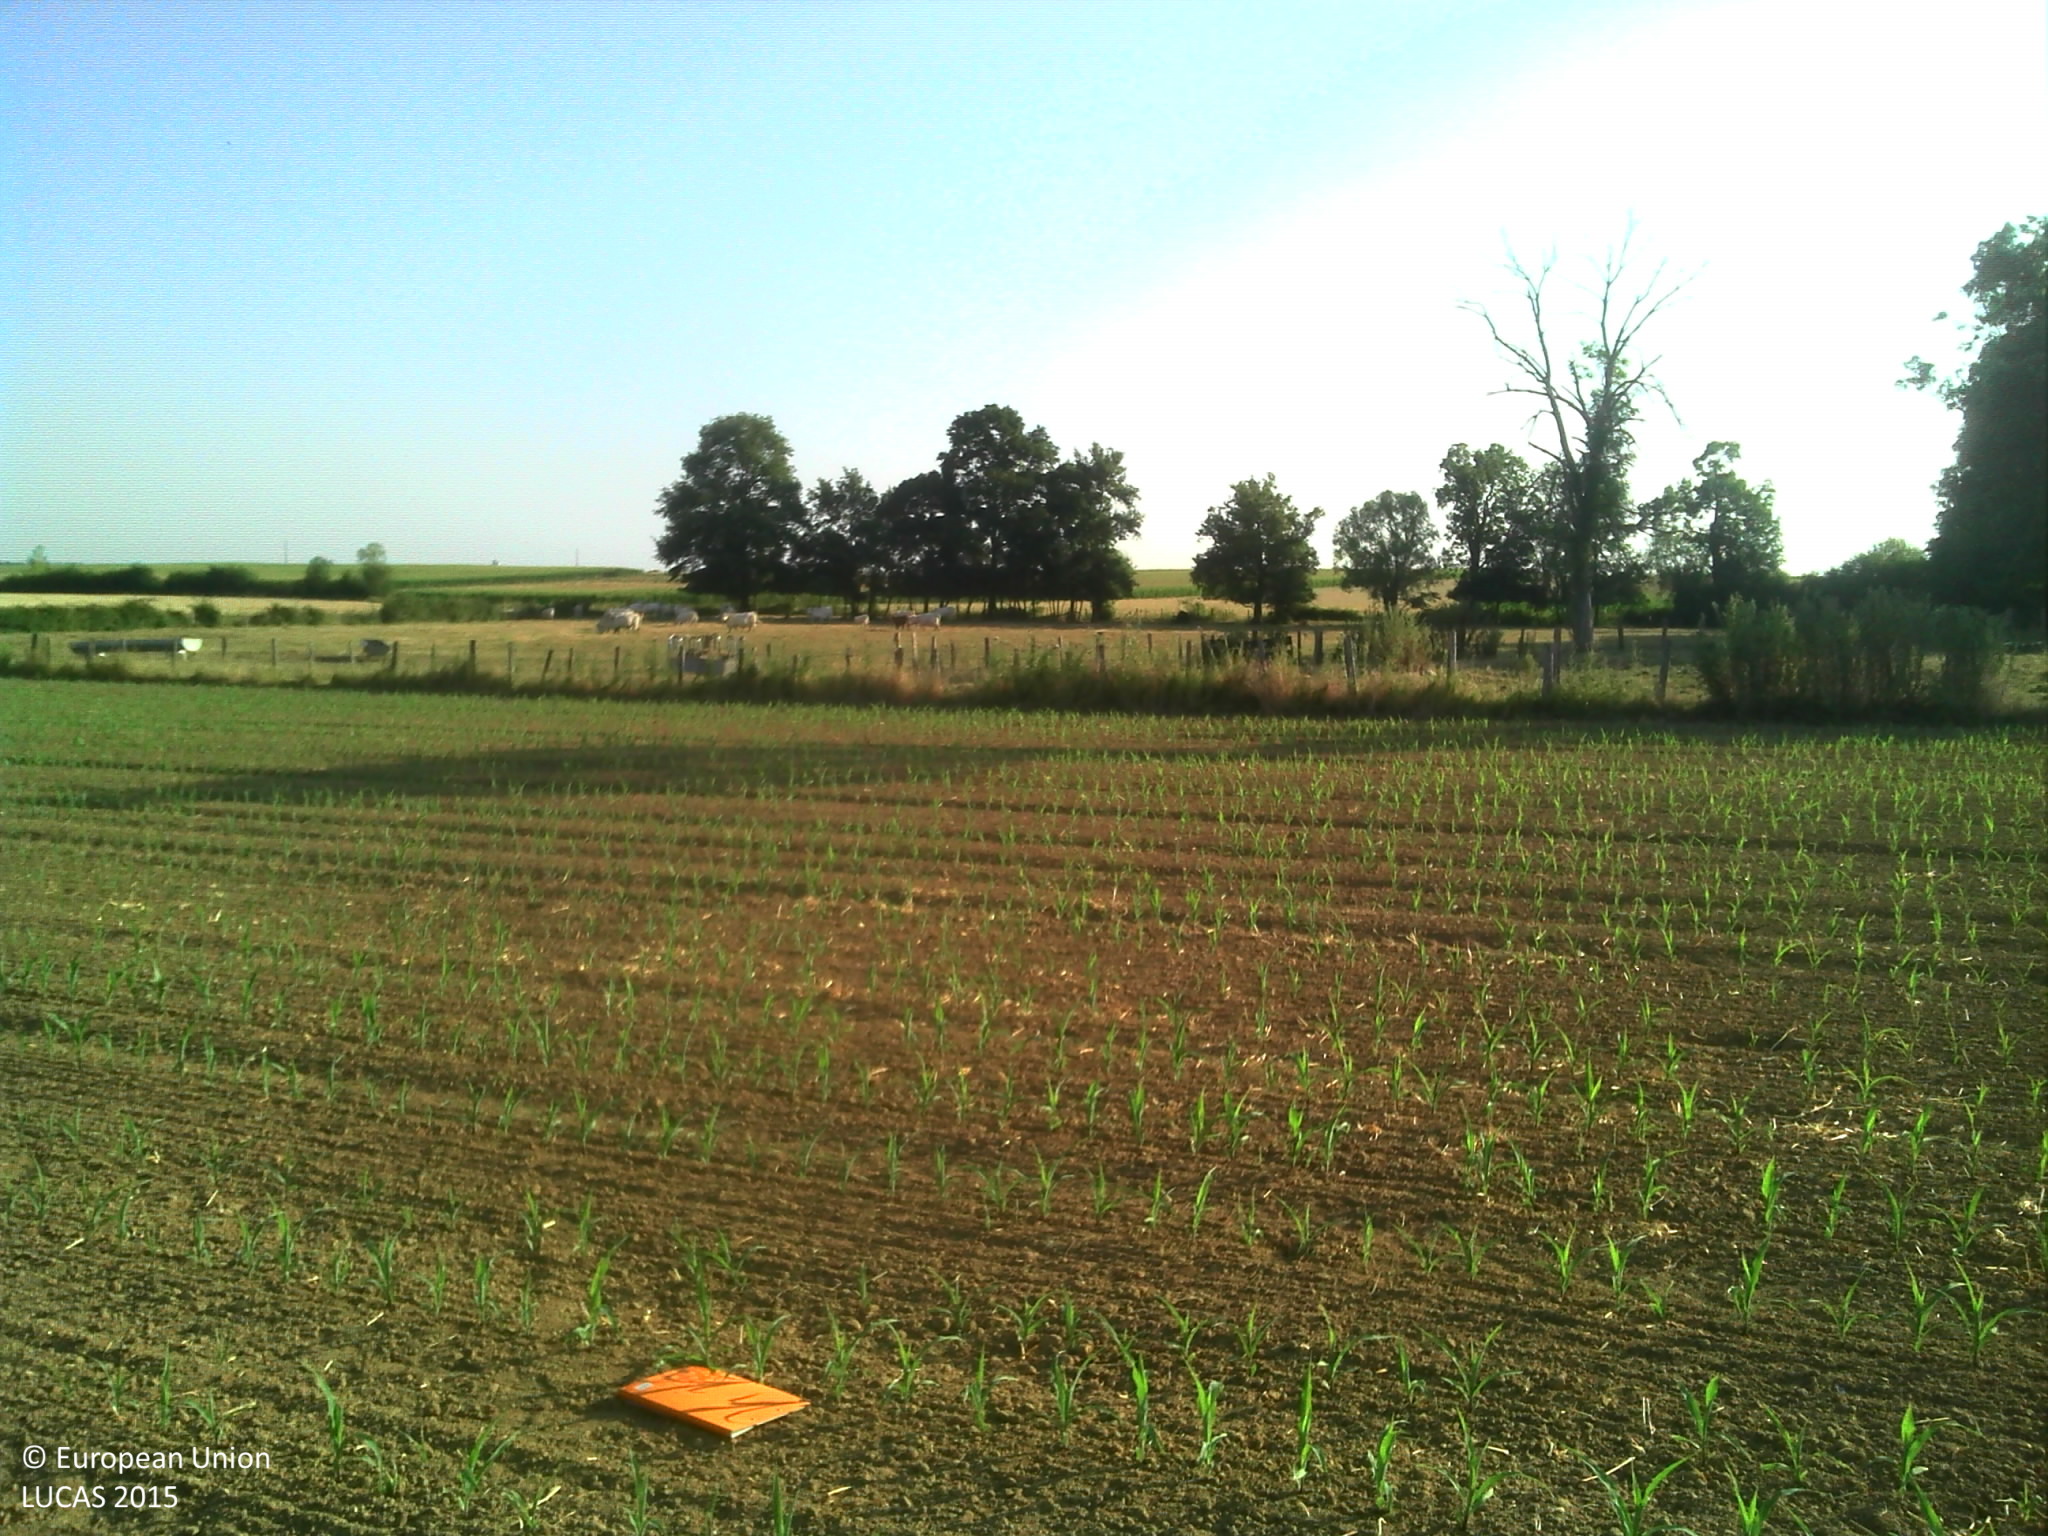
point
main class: Cropland
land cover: Maize
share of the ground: < 10 %
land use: Agriculture (excluding fallow land and kitchen gardens)
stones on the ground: < 10 %
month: July
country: FR
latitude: 46.8492
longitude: 5.0311
